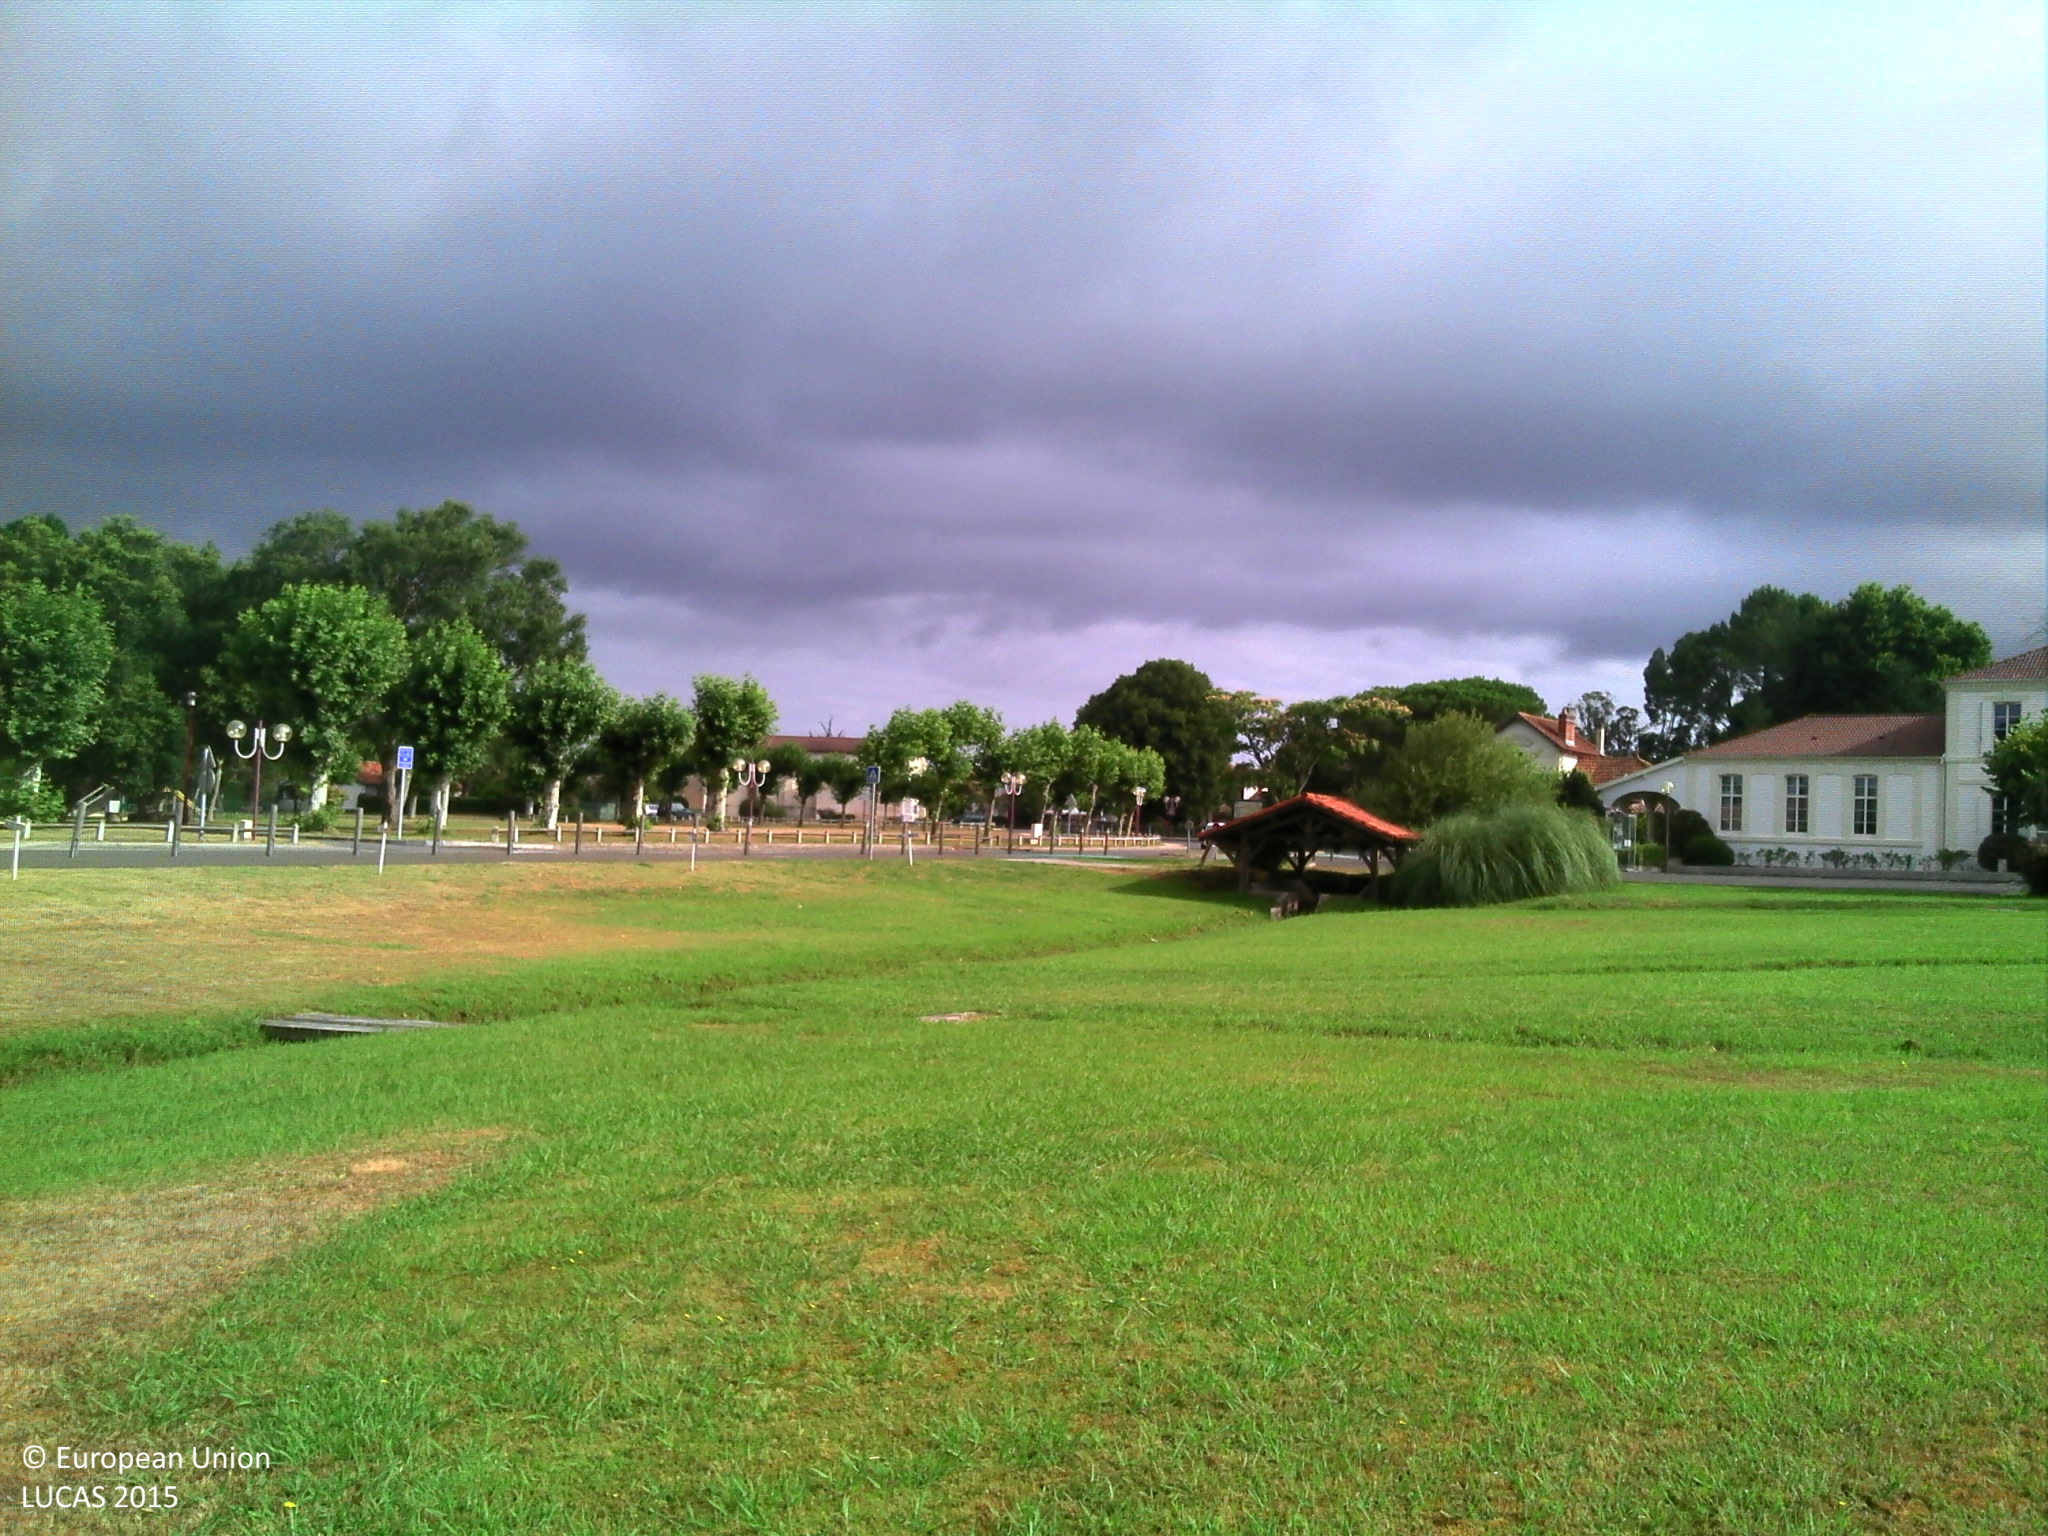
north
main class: Grassland
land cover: Grassland without tree/shrub cover
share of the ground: > 75 %
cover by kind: herbaceous plants 100 %
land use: Residential
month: July
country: FR
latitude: 44.2717
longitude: -1.1835
